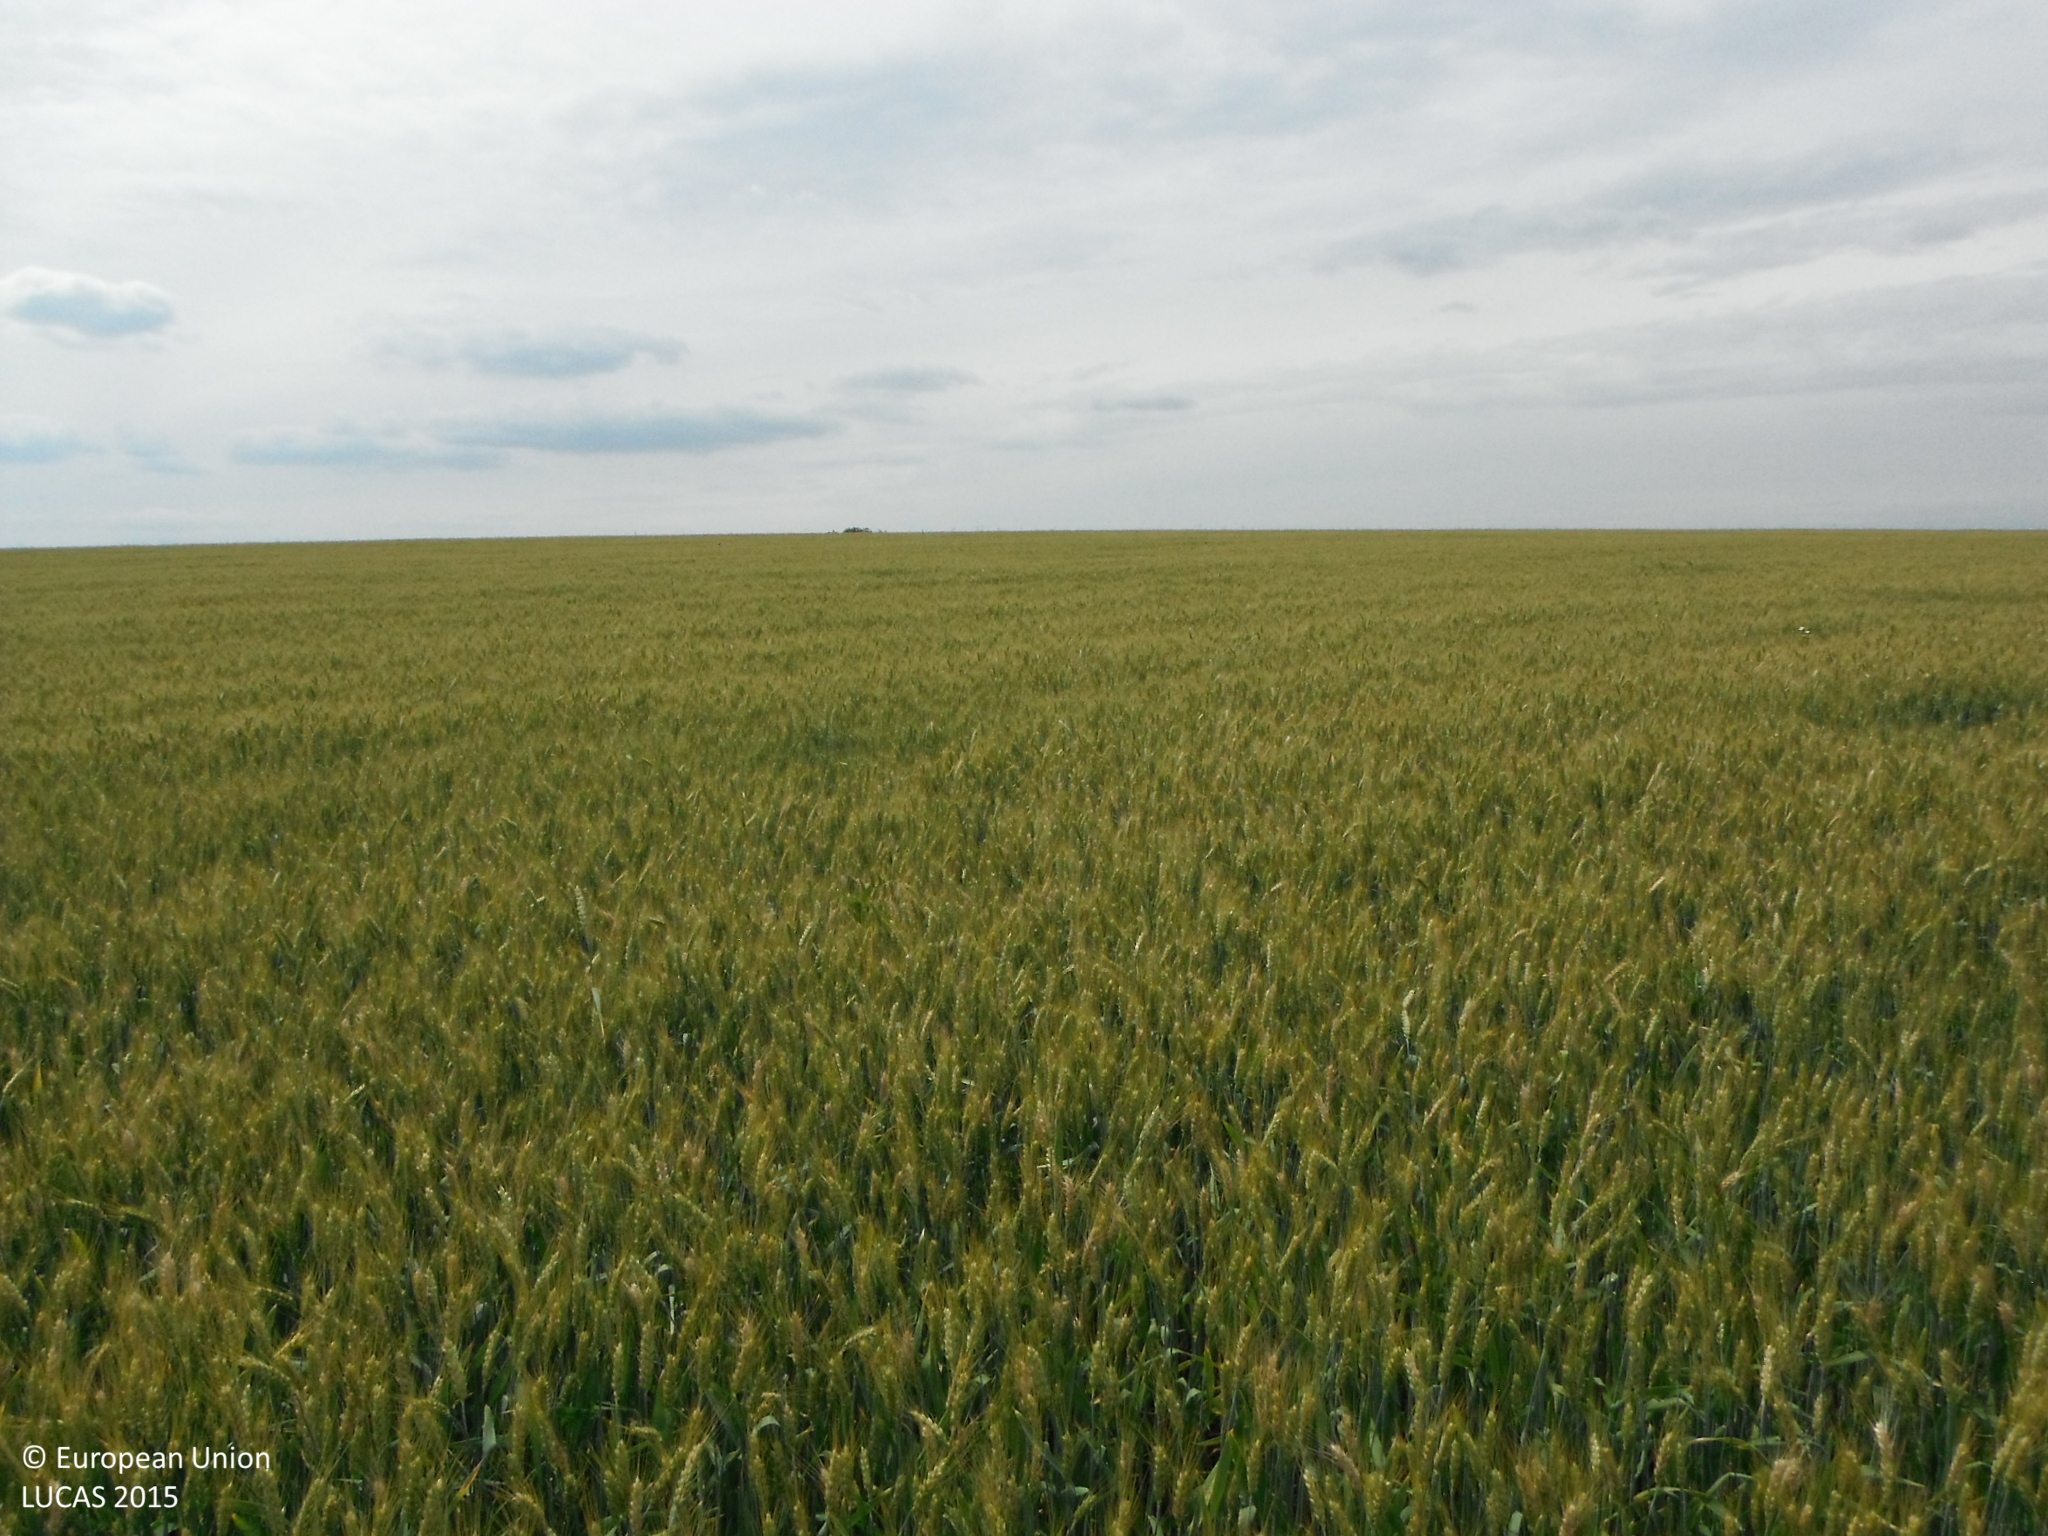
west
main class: Cropland
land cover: Common wheat
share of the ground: > 75 %
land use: Agriculture (excluding fallow land and kitchen gardens)
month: June
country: SK
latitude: 48.2759
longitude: 18.2475
